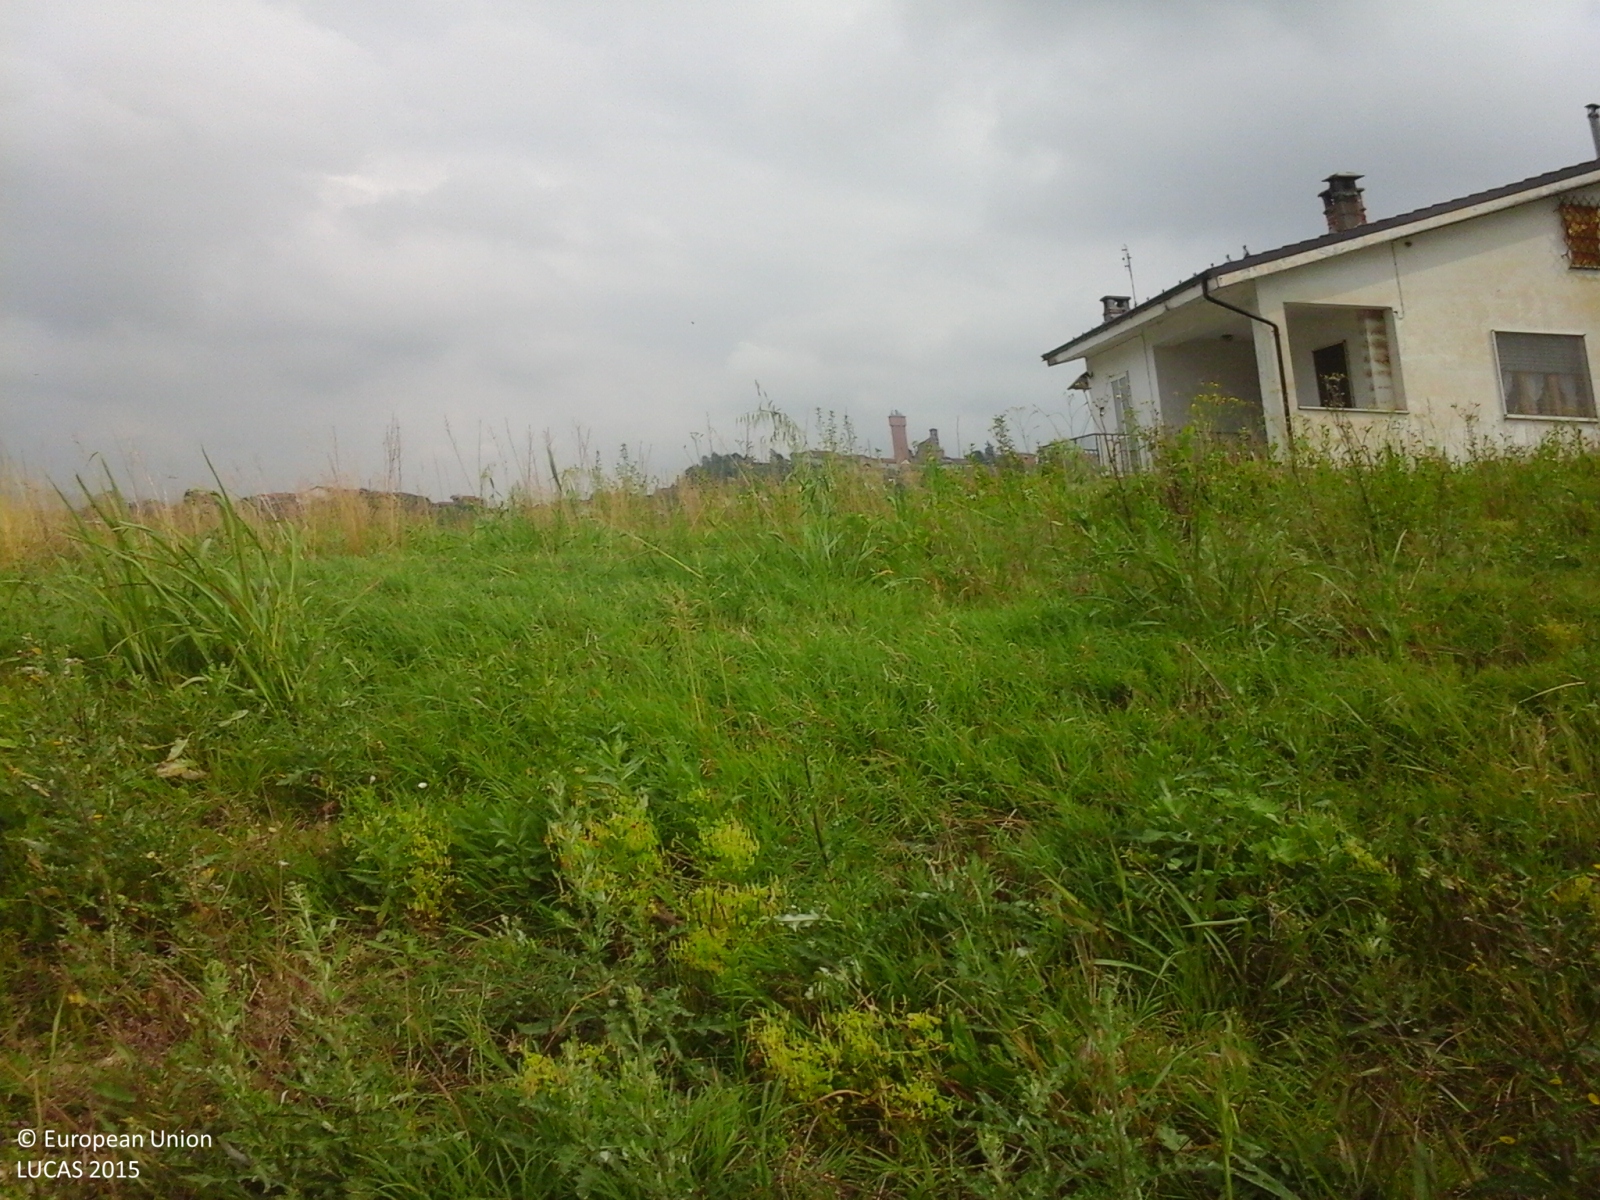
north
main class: Grassland
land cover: Spontaneously vegetated surfaces
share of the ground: > 75 %
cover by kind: herbaceous plants 100 %
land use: Fallow land
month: May
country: IT
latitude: 44.8403
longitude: 8.2197
